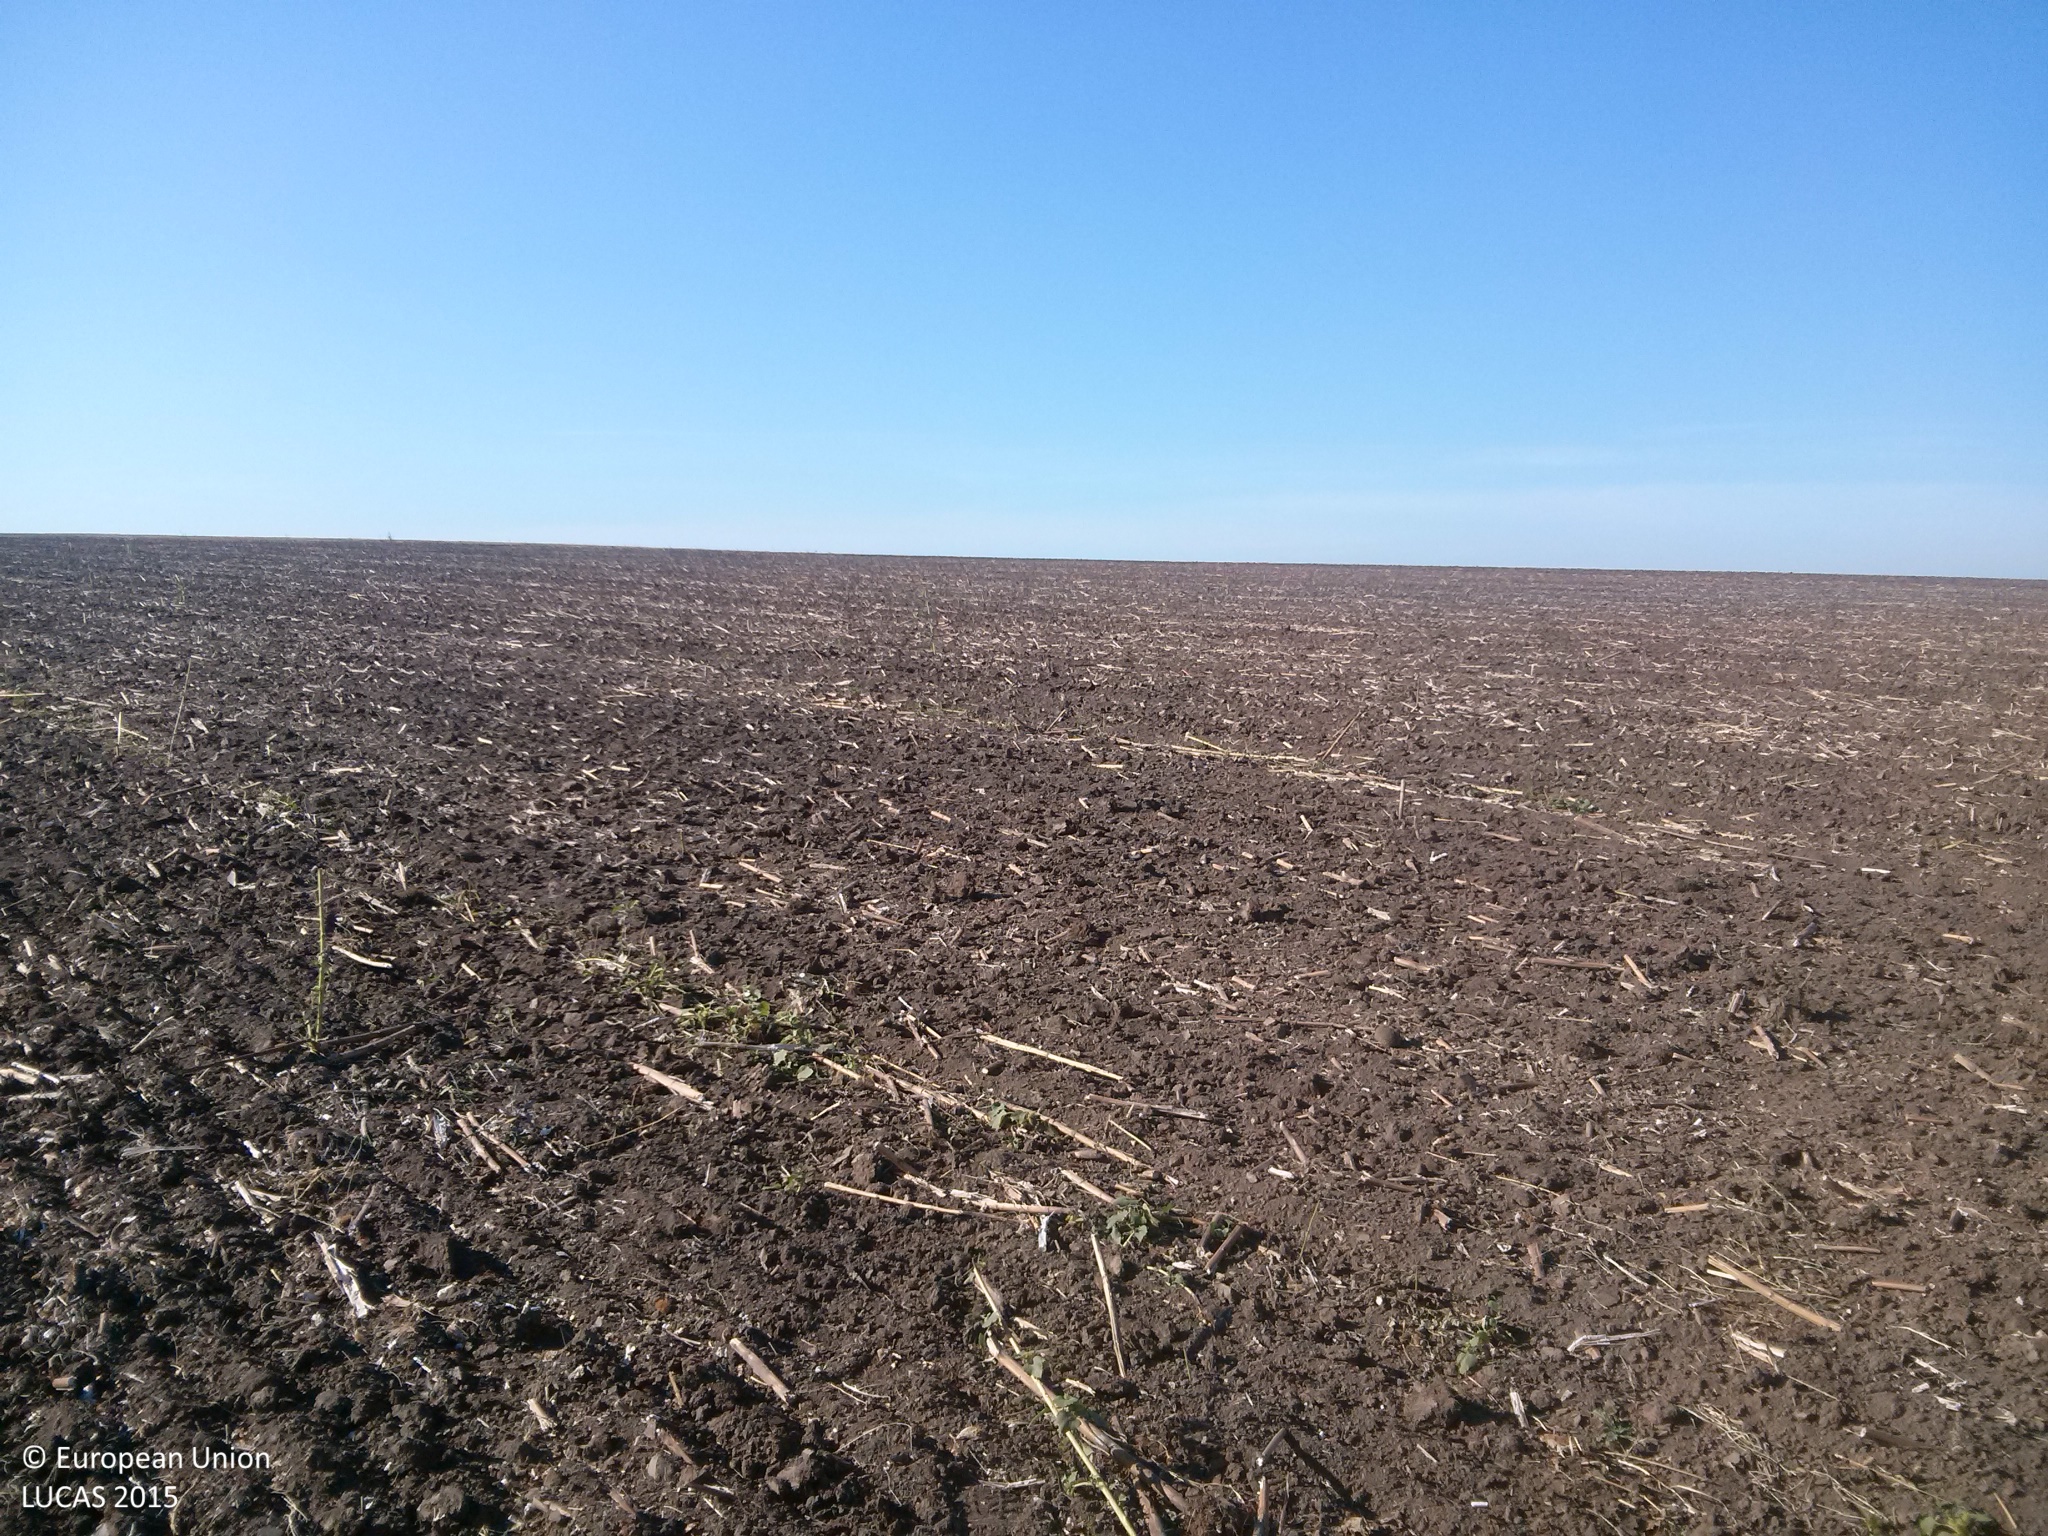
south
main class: Cropland
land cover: Sunflower
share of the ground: < 10 %
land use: Agriculture (excluding fallow land and kitchen gardens)
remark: Harvested field
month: September
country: BG
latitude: 43.7459
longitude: 26.4355
